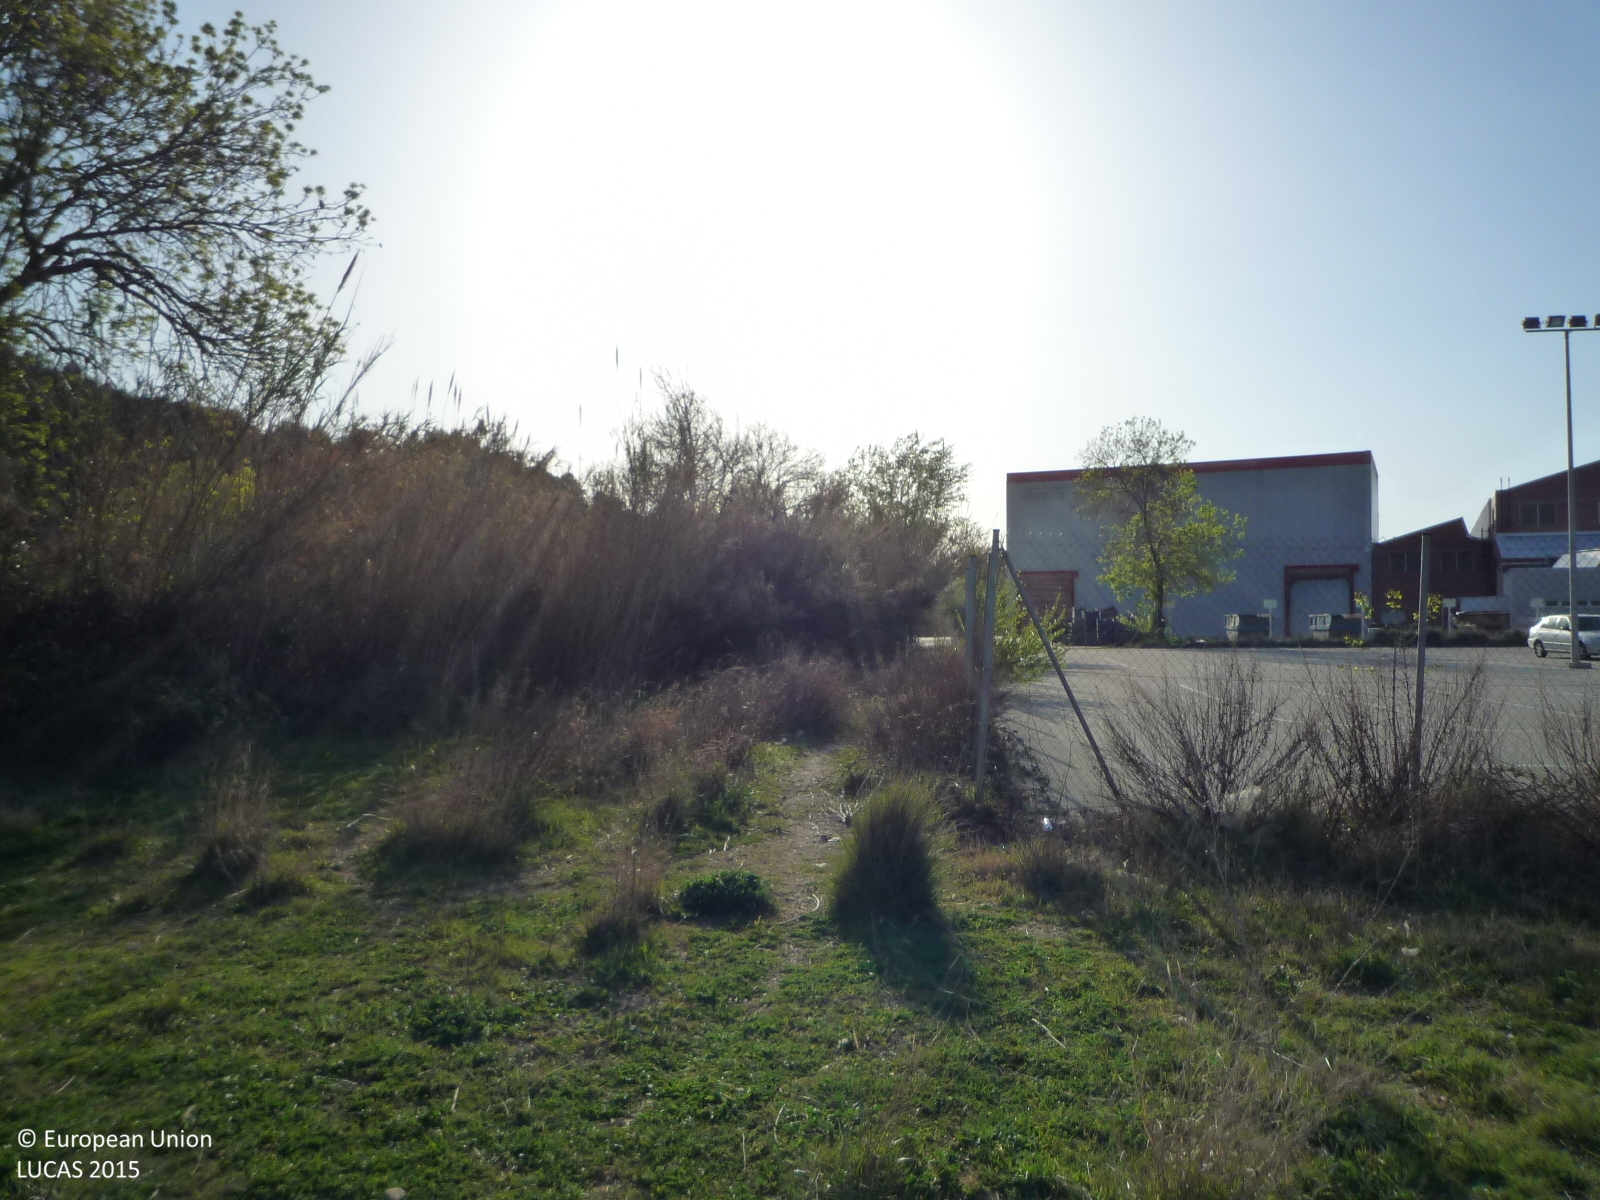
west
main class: Grassland
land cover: Grassland without tree/shrub cover
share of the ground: > 75 %
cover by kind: herbaceous plants 95 %, shrubs 5 %
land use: Abandoned areas
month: April
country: ES
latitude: 41.5651
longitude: 1.6577
